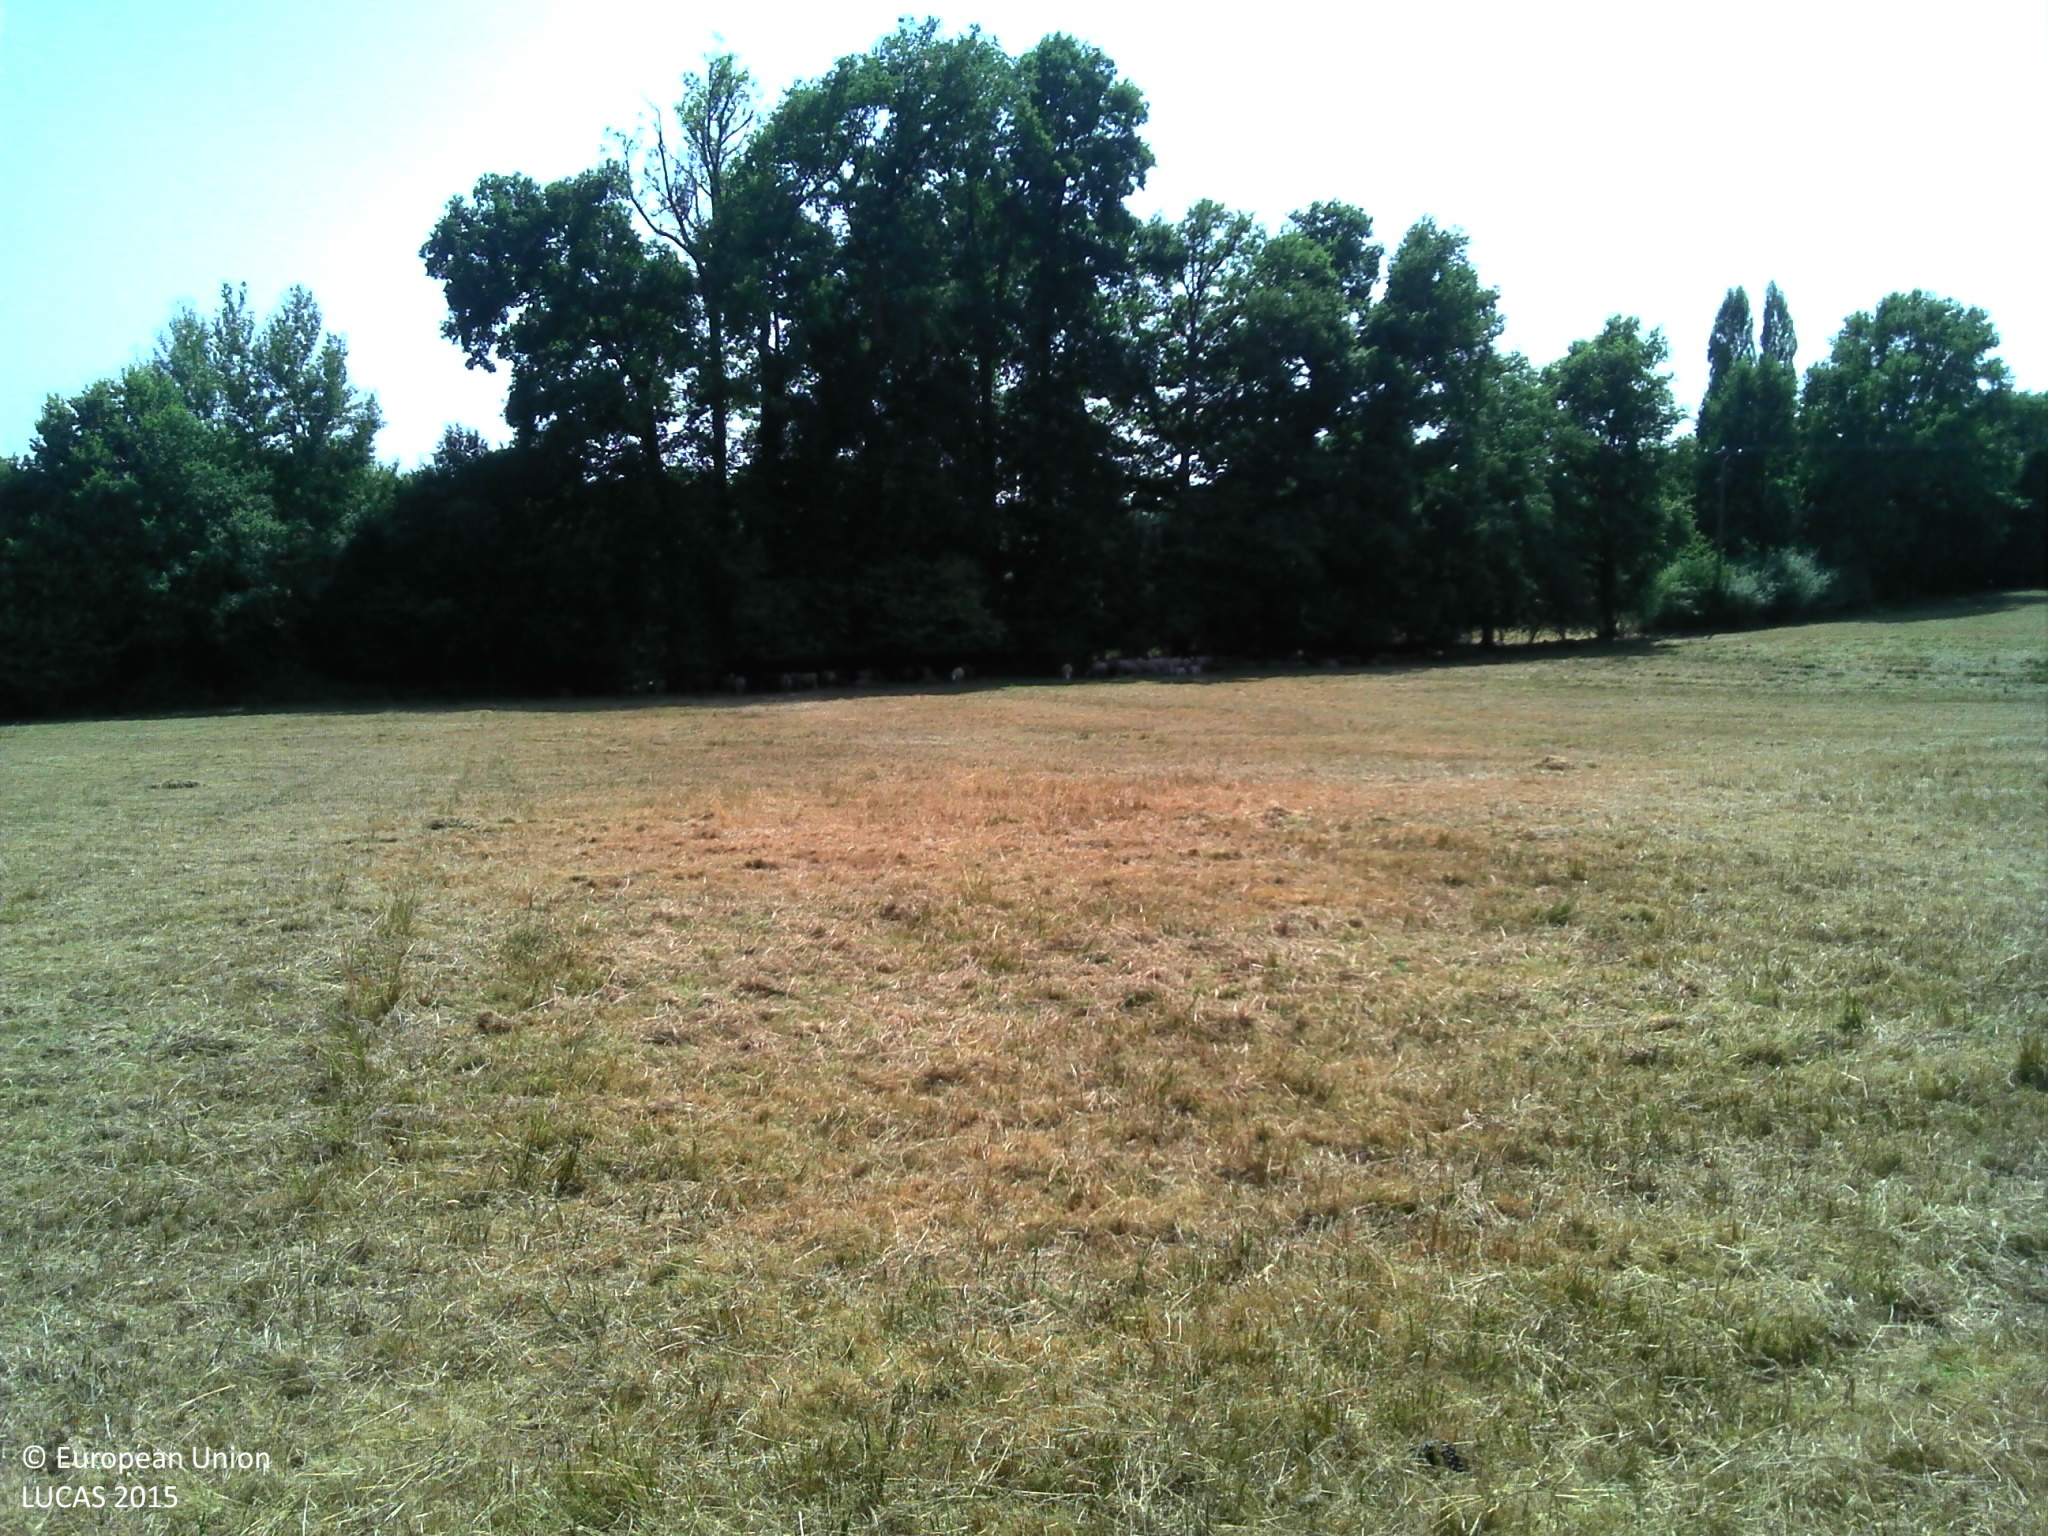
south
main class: Grassland
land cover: Grassland without tree/shrub cover
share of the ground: > 75 %
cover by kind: herbaceous plants 95 %
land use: Agriculture (excluding fallow land and kitchen gardens)
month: July
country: FR
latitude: 45.7719
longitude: 1.0004
